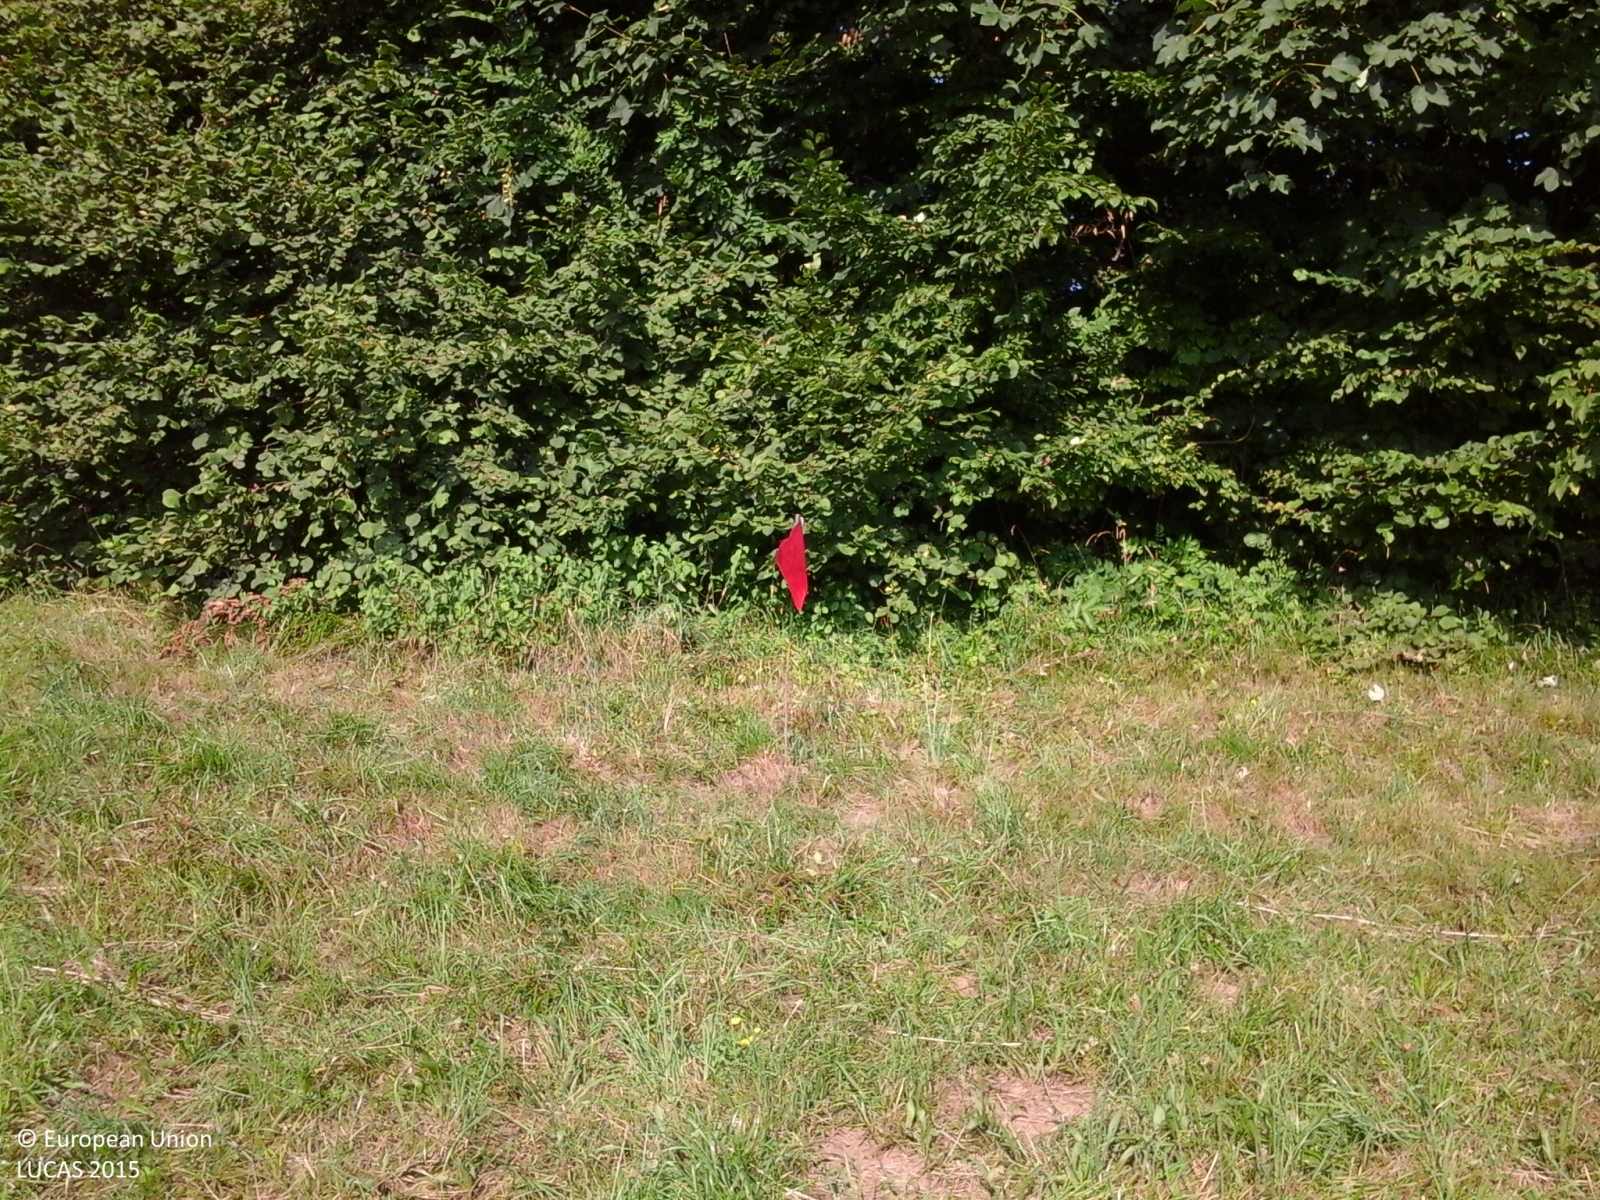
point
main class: Grassland
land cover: Grassland without tree/shrub cover
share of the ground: > 75 %
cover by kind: herbaceous plants 100 %
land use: Agriculture (excluding fallow land and kitchen gardens)
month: July
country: IT
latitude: 46.1307
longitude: 12.1846
